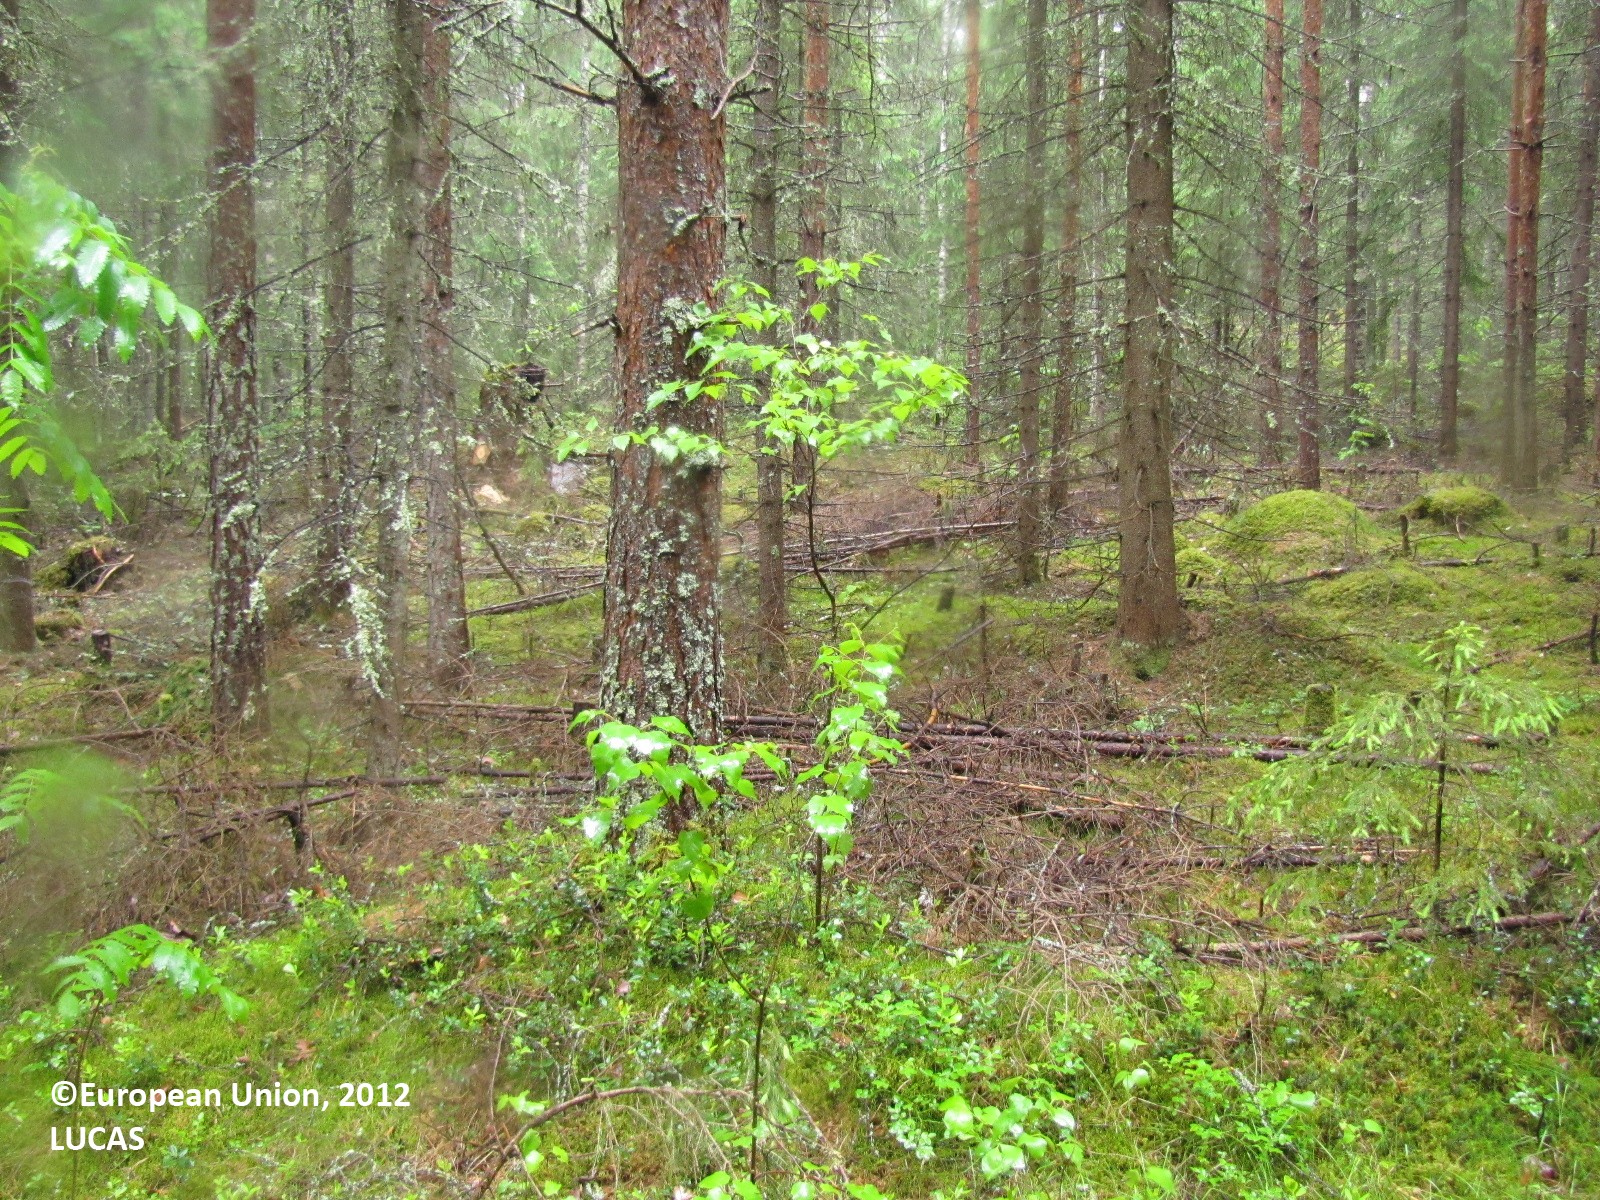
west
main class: Woodland
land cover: Spruce dominated coniferous woodland
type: boreal forest
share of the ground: > 75 %
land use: Forestry
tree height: > 5 m
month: June
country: FI
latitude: 61.6478
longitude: 24.4999
